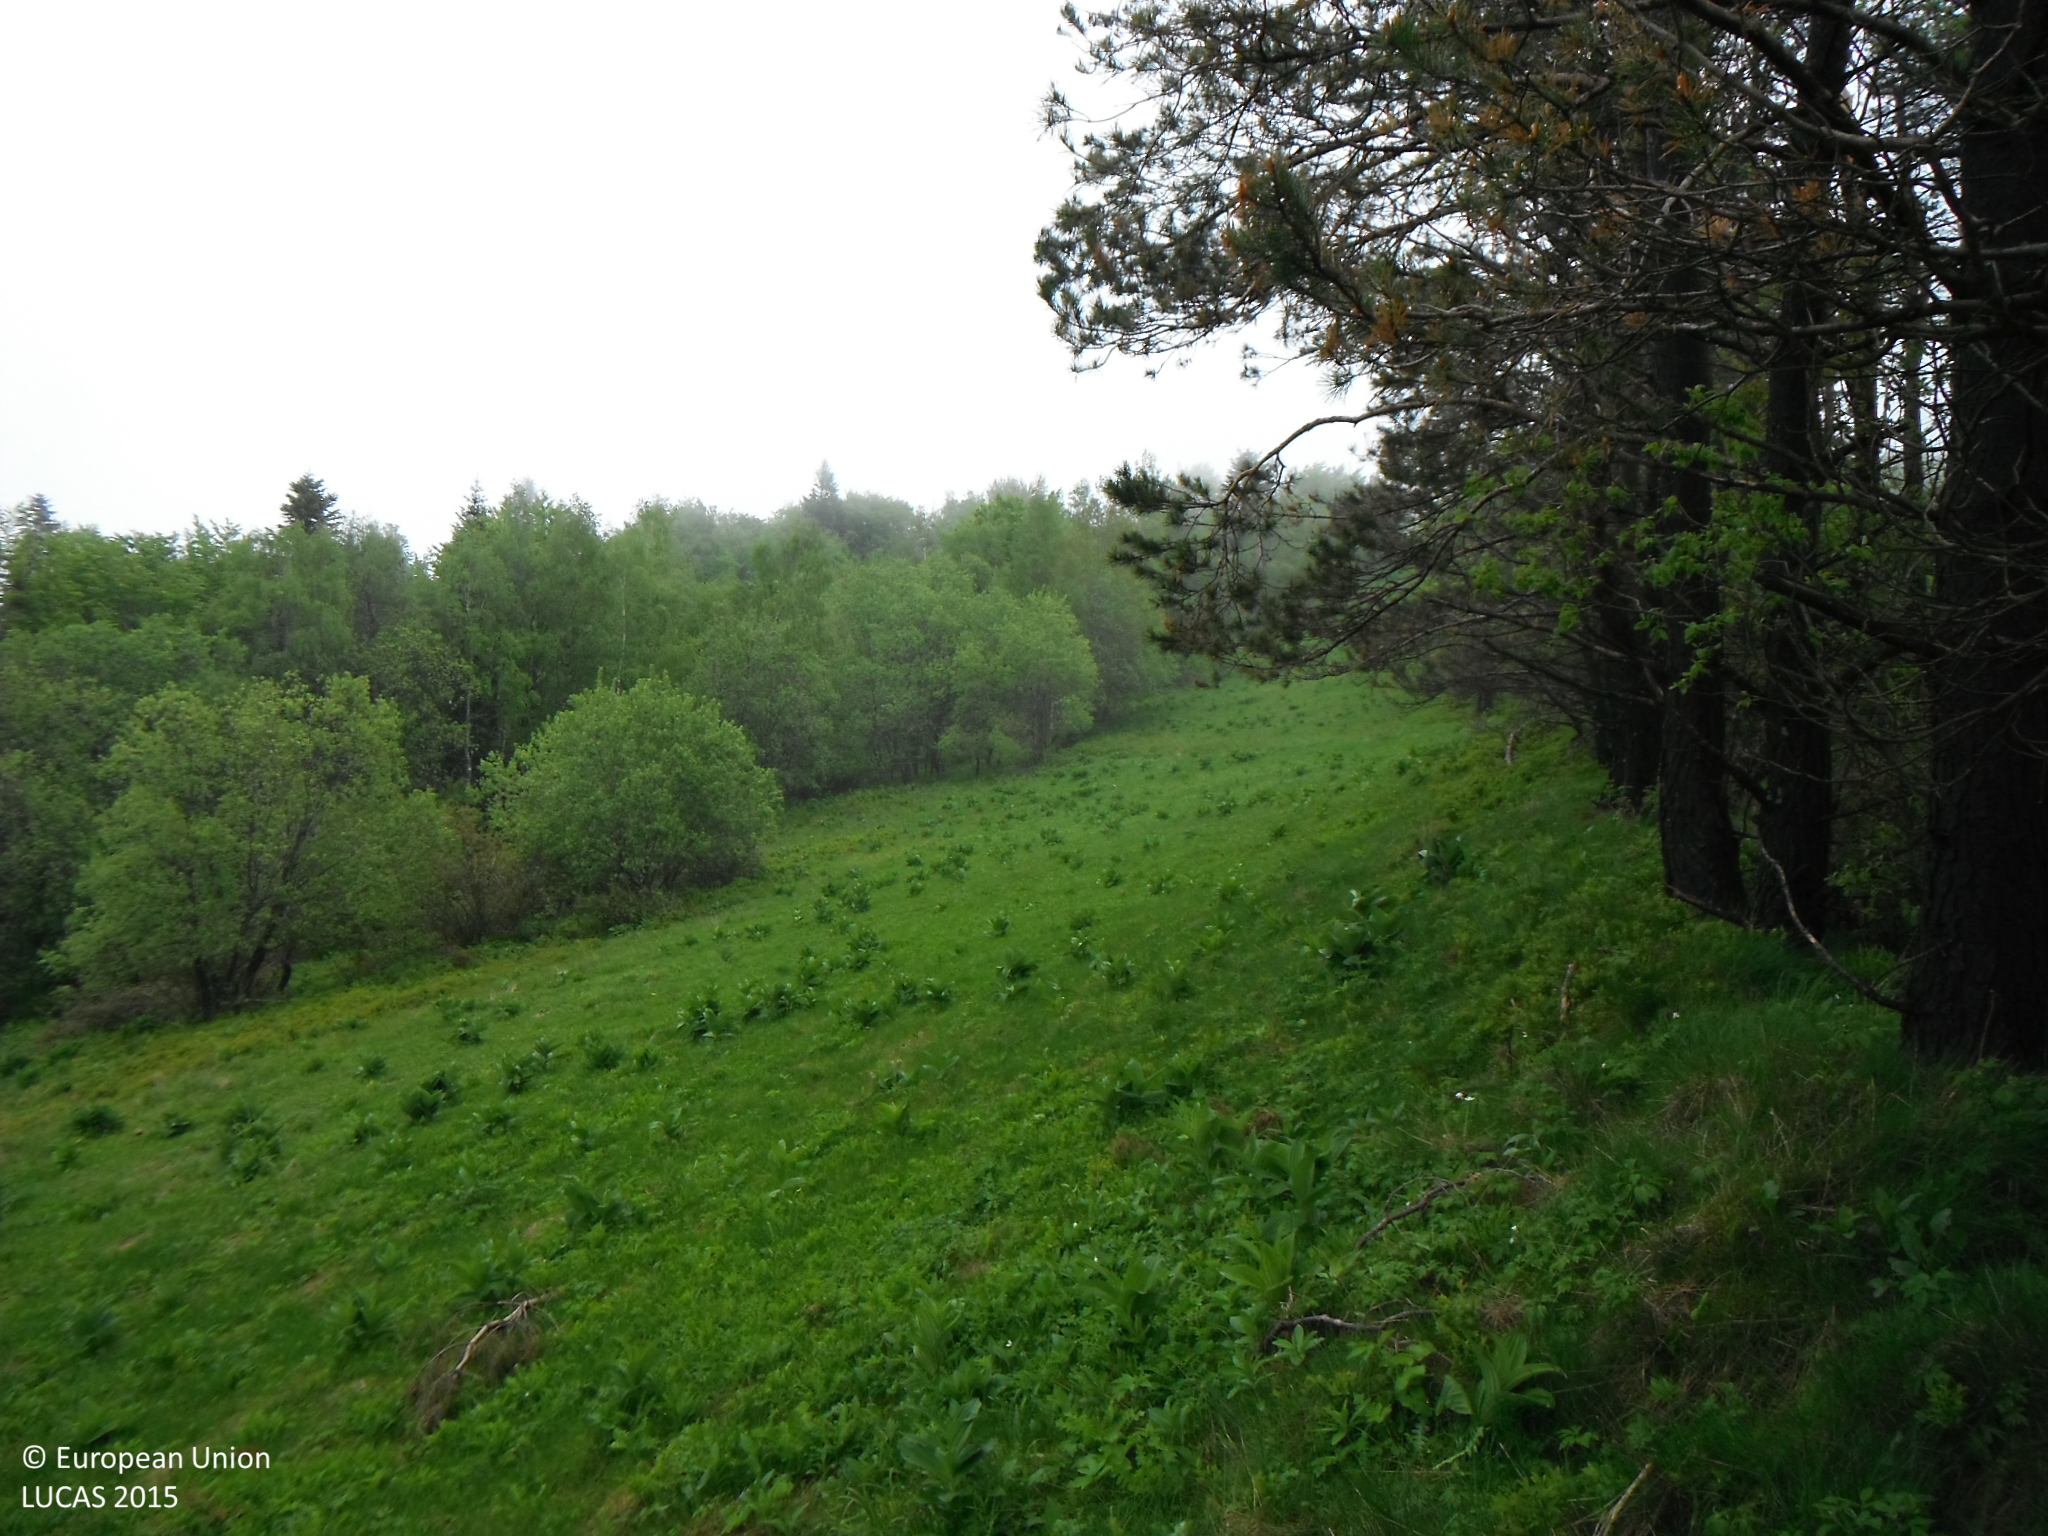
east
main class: Grassland
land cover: Spontaneously vegetated surfaces
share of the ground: > 75 %
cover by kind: herbaceous plants 100 %
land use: Sport
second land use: Amenities, museums, leisure
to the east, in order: Spontaneously vegetated surfaces; Shrubland with sparse tree cover; Broadleaved woodland; Tracks; Broadleaved woodland; Spontaneously vegetated surfaces; Tracks; Spontaneously vegetated surfaces; Broadleaved woodland
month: May
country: SK
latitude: 49.1645
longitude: 21.1388
